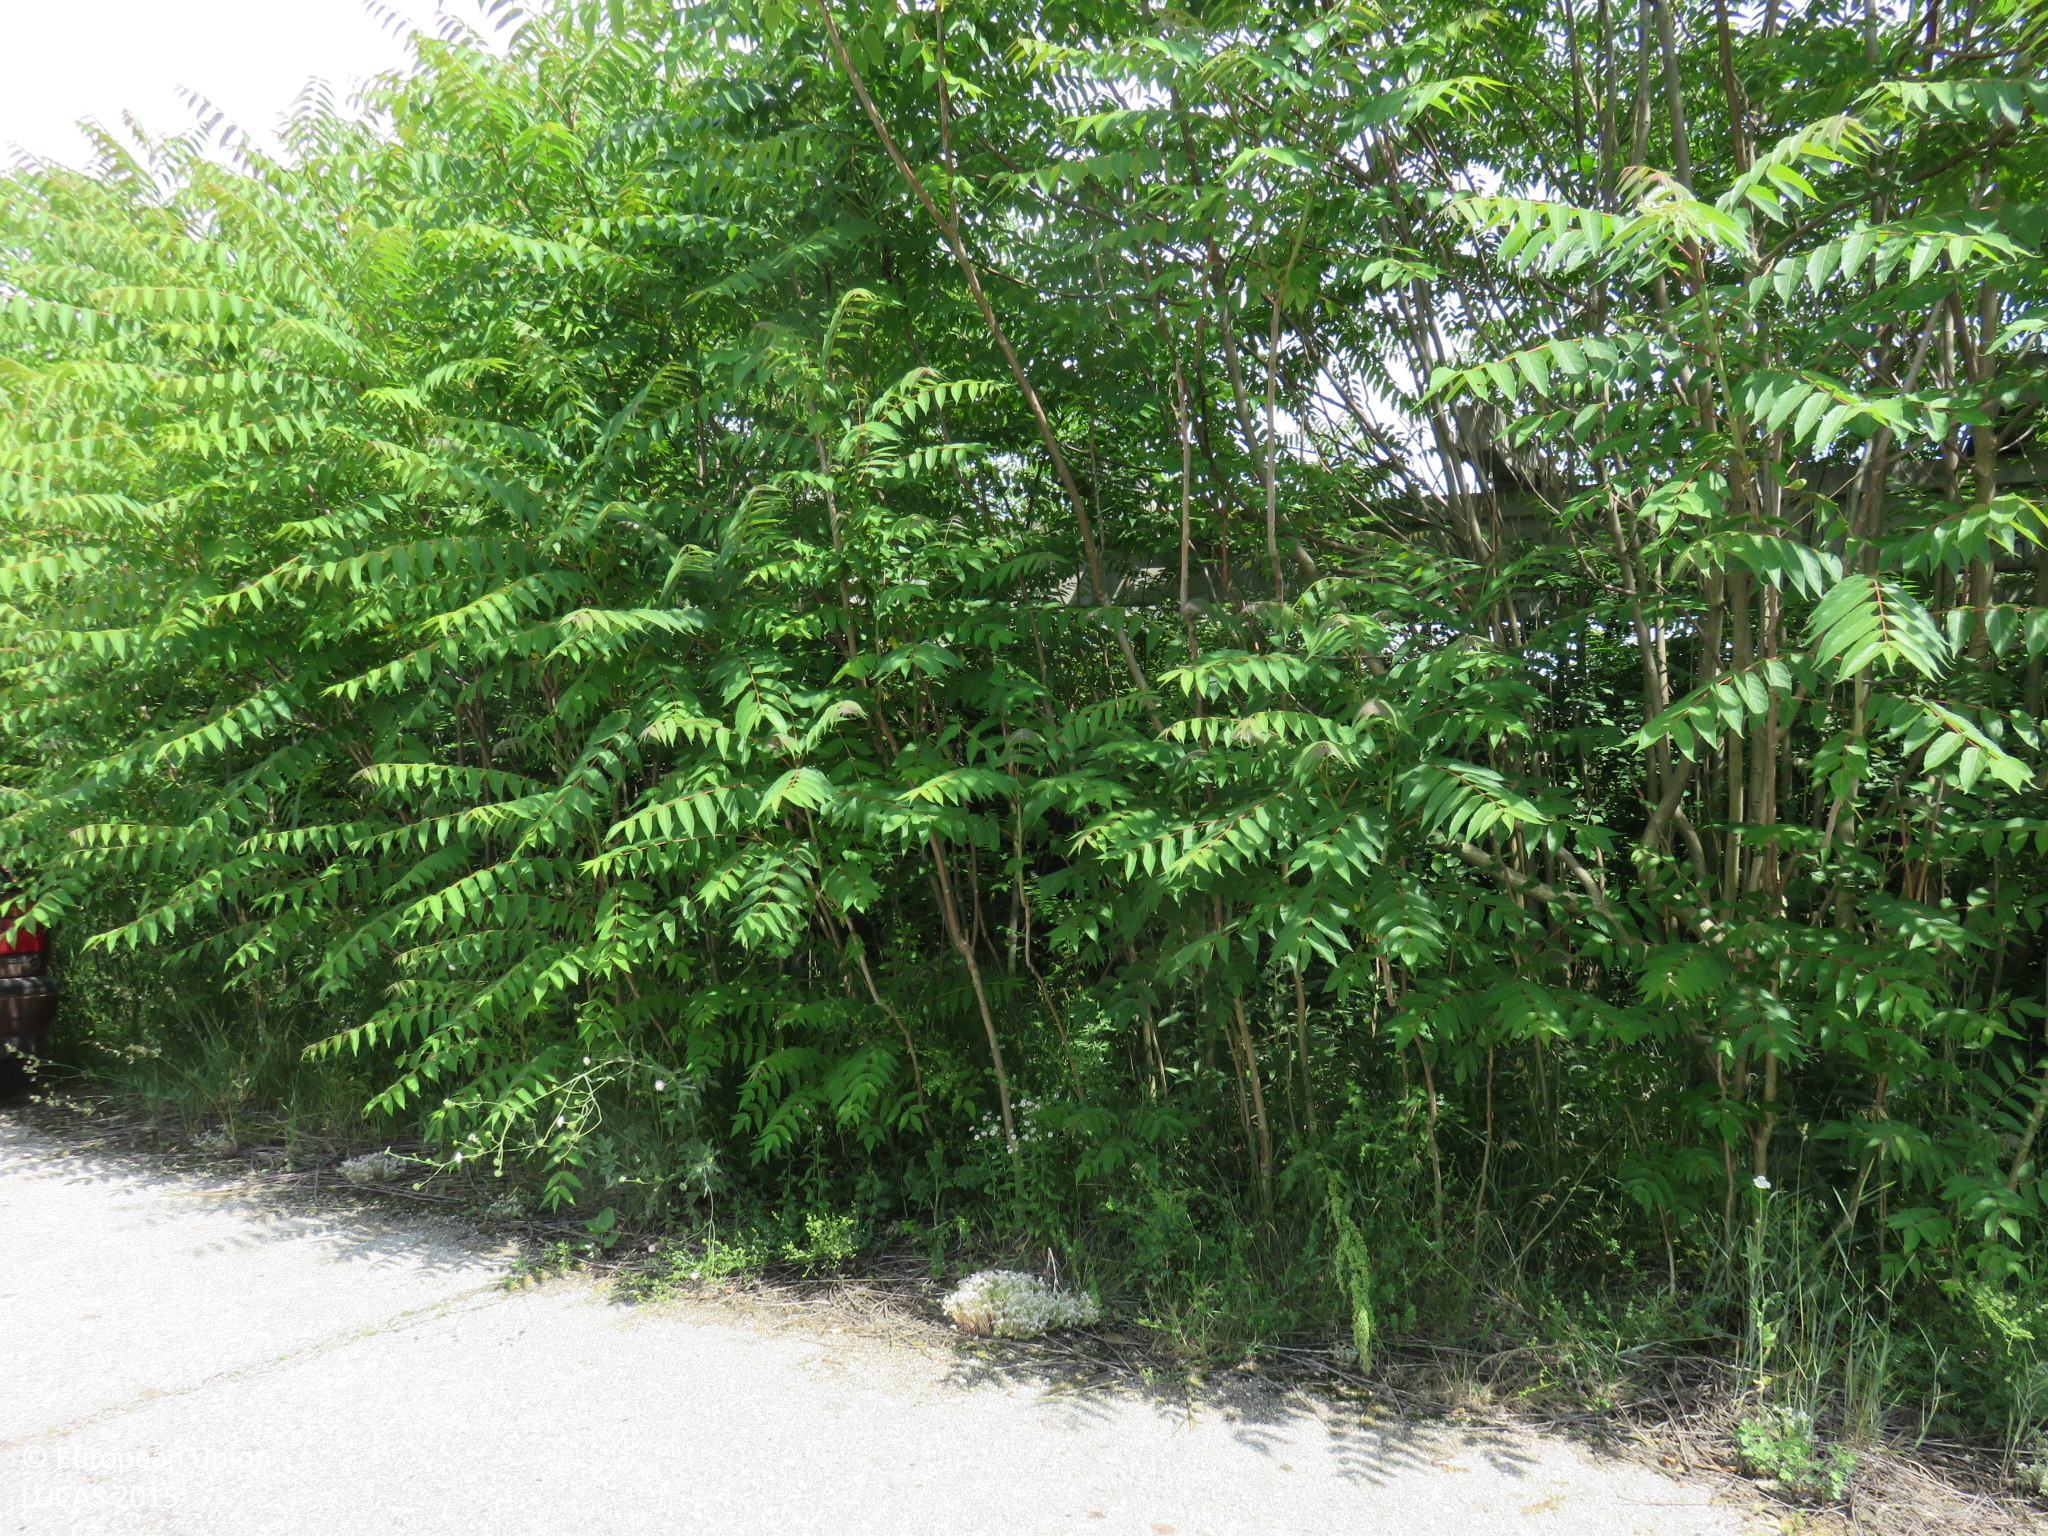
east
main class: Woodland
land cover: Broadleaved woodland
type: mesophytic deciduous forest
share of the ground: > 75 %
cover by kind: broadleaved forest trees 80 %, shrubs 15 %, herbaceous plants 5 %
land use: Semi-natural and natural areas not in use
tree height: < 5 m
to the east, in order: Paved roads, cycling and walking lanes; Shrubland with sparse tree cover; Artificial constructions in urban areas; Shrubland with sparse tree cover
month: June
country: BG
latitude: 43.3998
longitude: 24.4942
